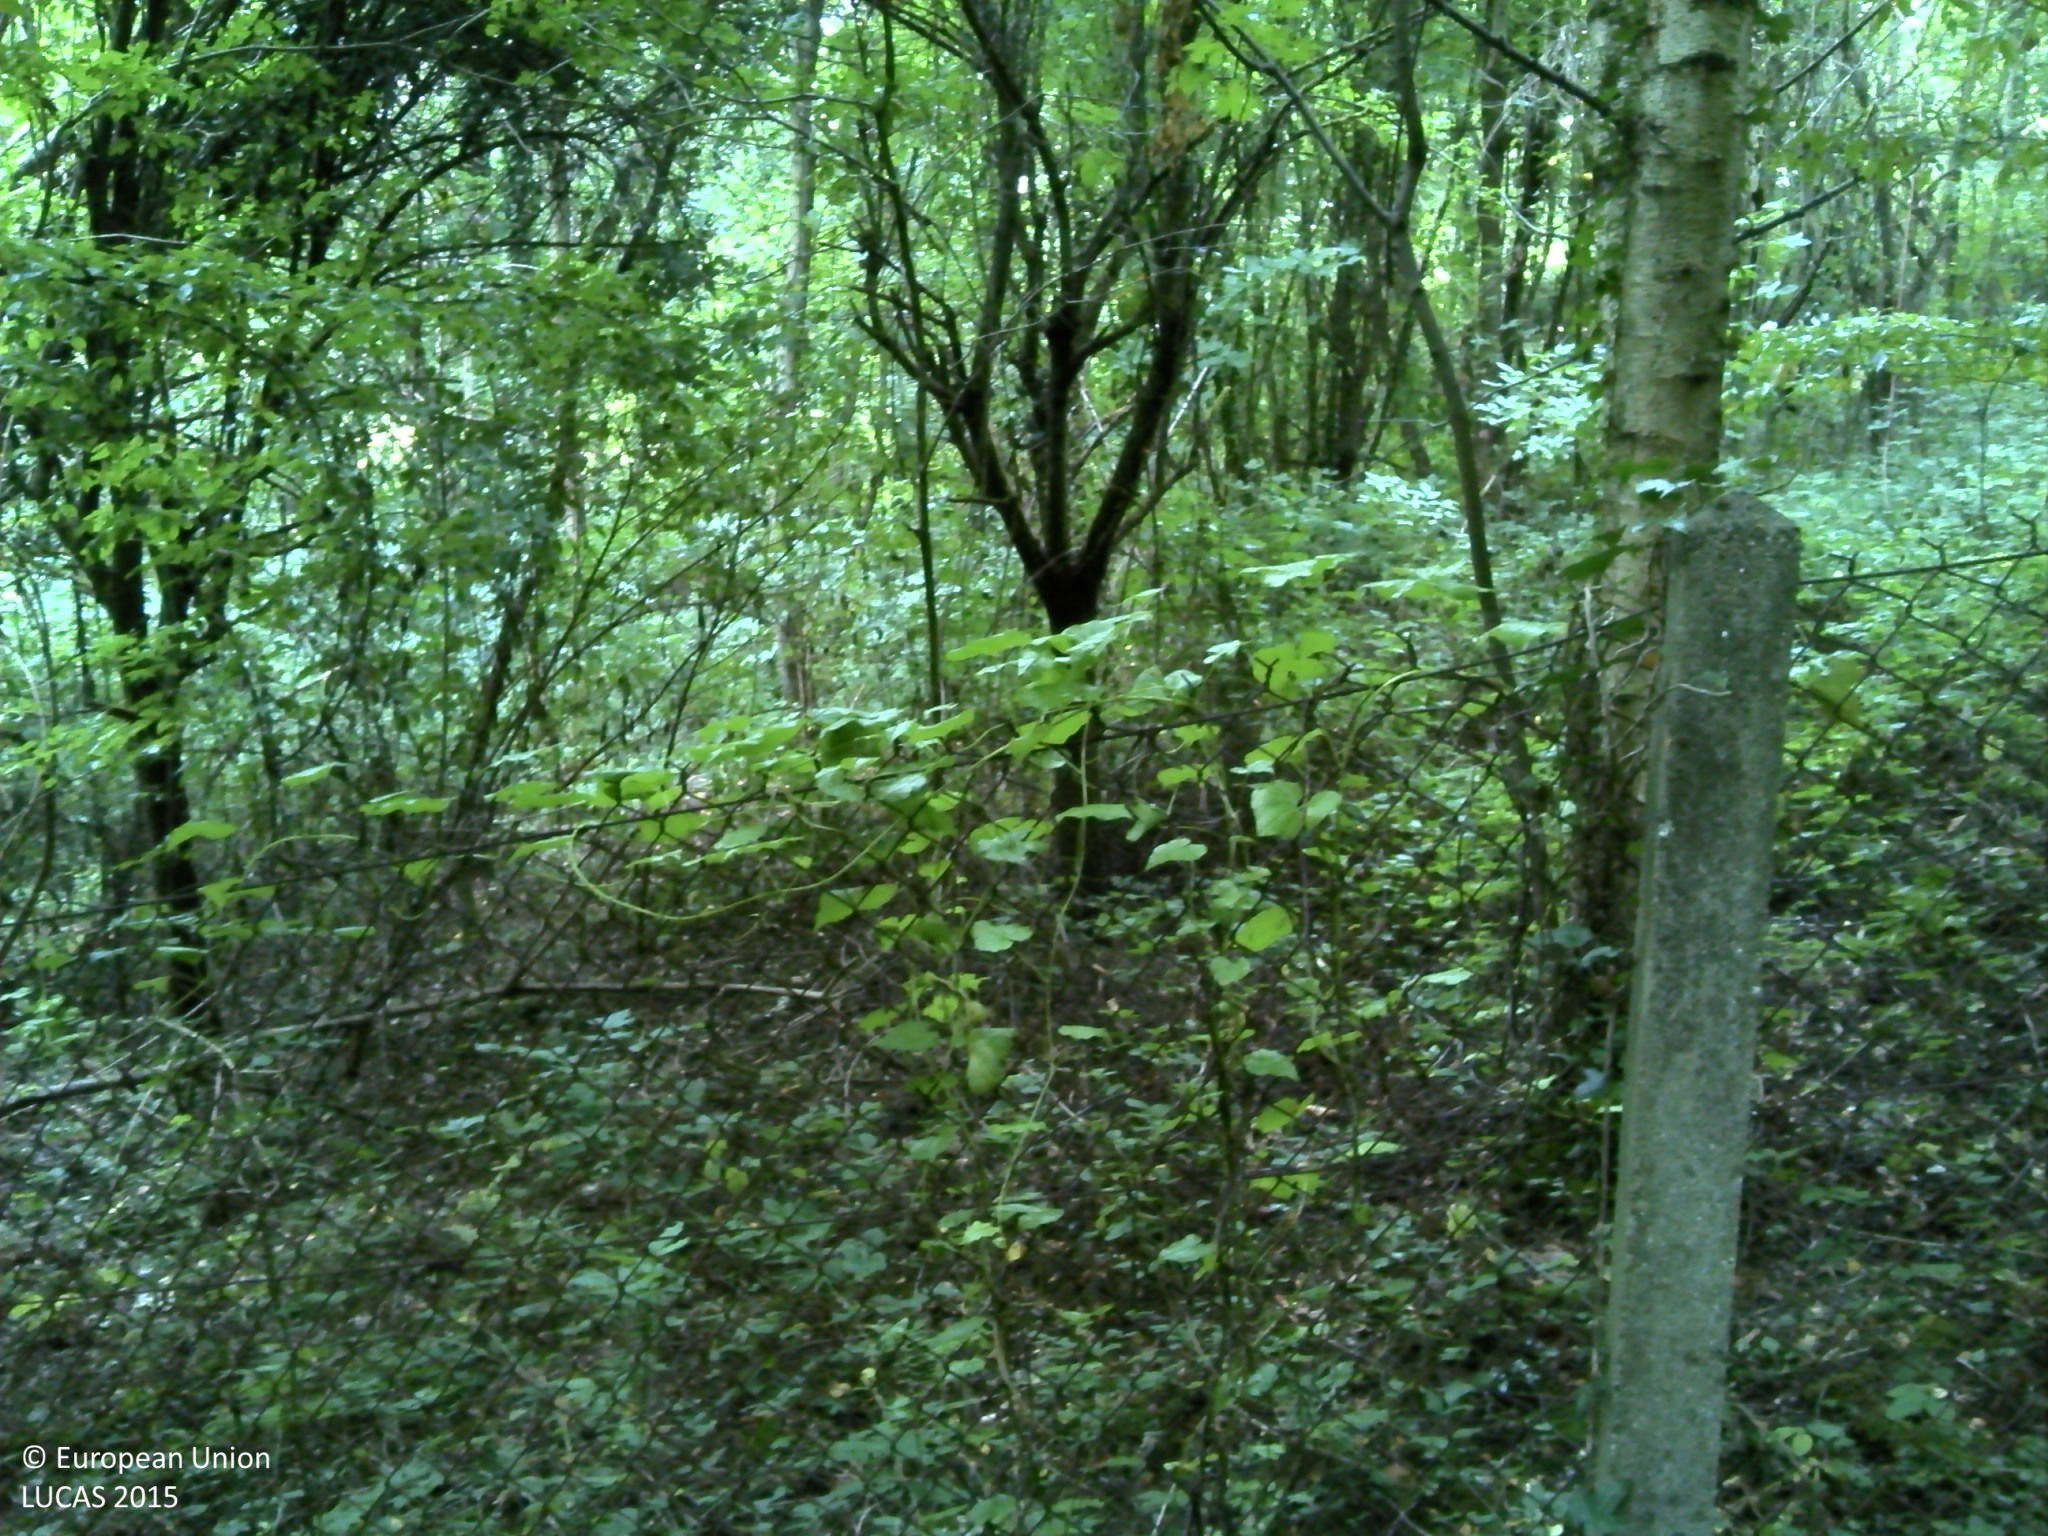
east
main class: Woodland
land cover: Broadleaved woodland
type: mesophytic deciduous forest
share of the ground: > 75 %
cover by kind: broadleaved forest trees 95 %, herbaceous plants 5 %
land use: Forestry
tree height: > 5 m
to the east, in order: Broadleaved woodland; Artificial constructions in urban areas; Broadleaved woodland
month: July
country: FR
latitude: 48.7524
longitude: 1.8377
